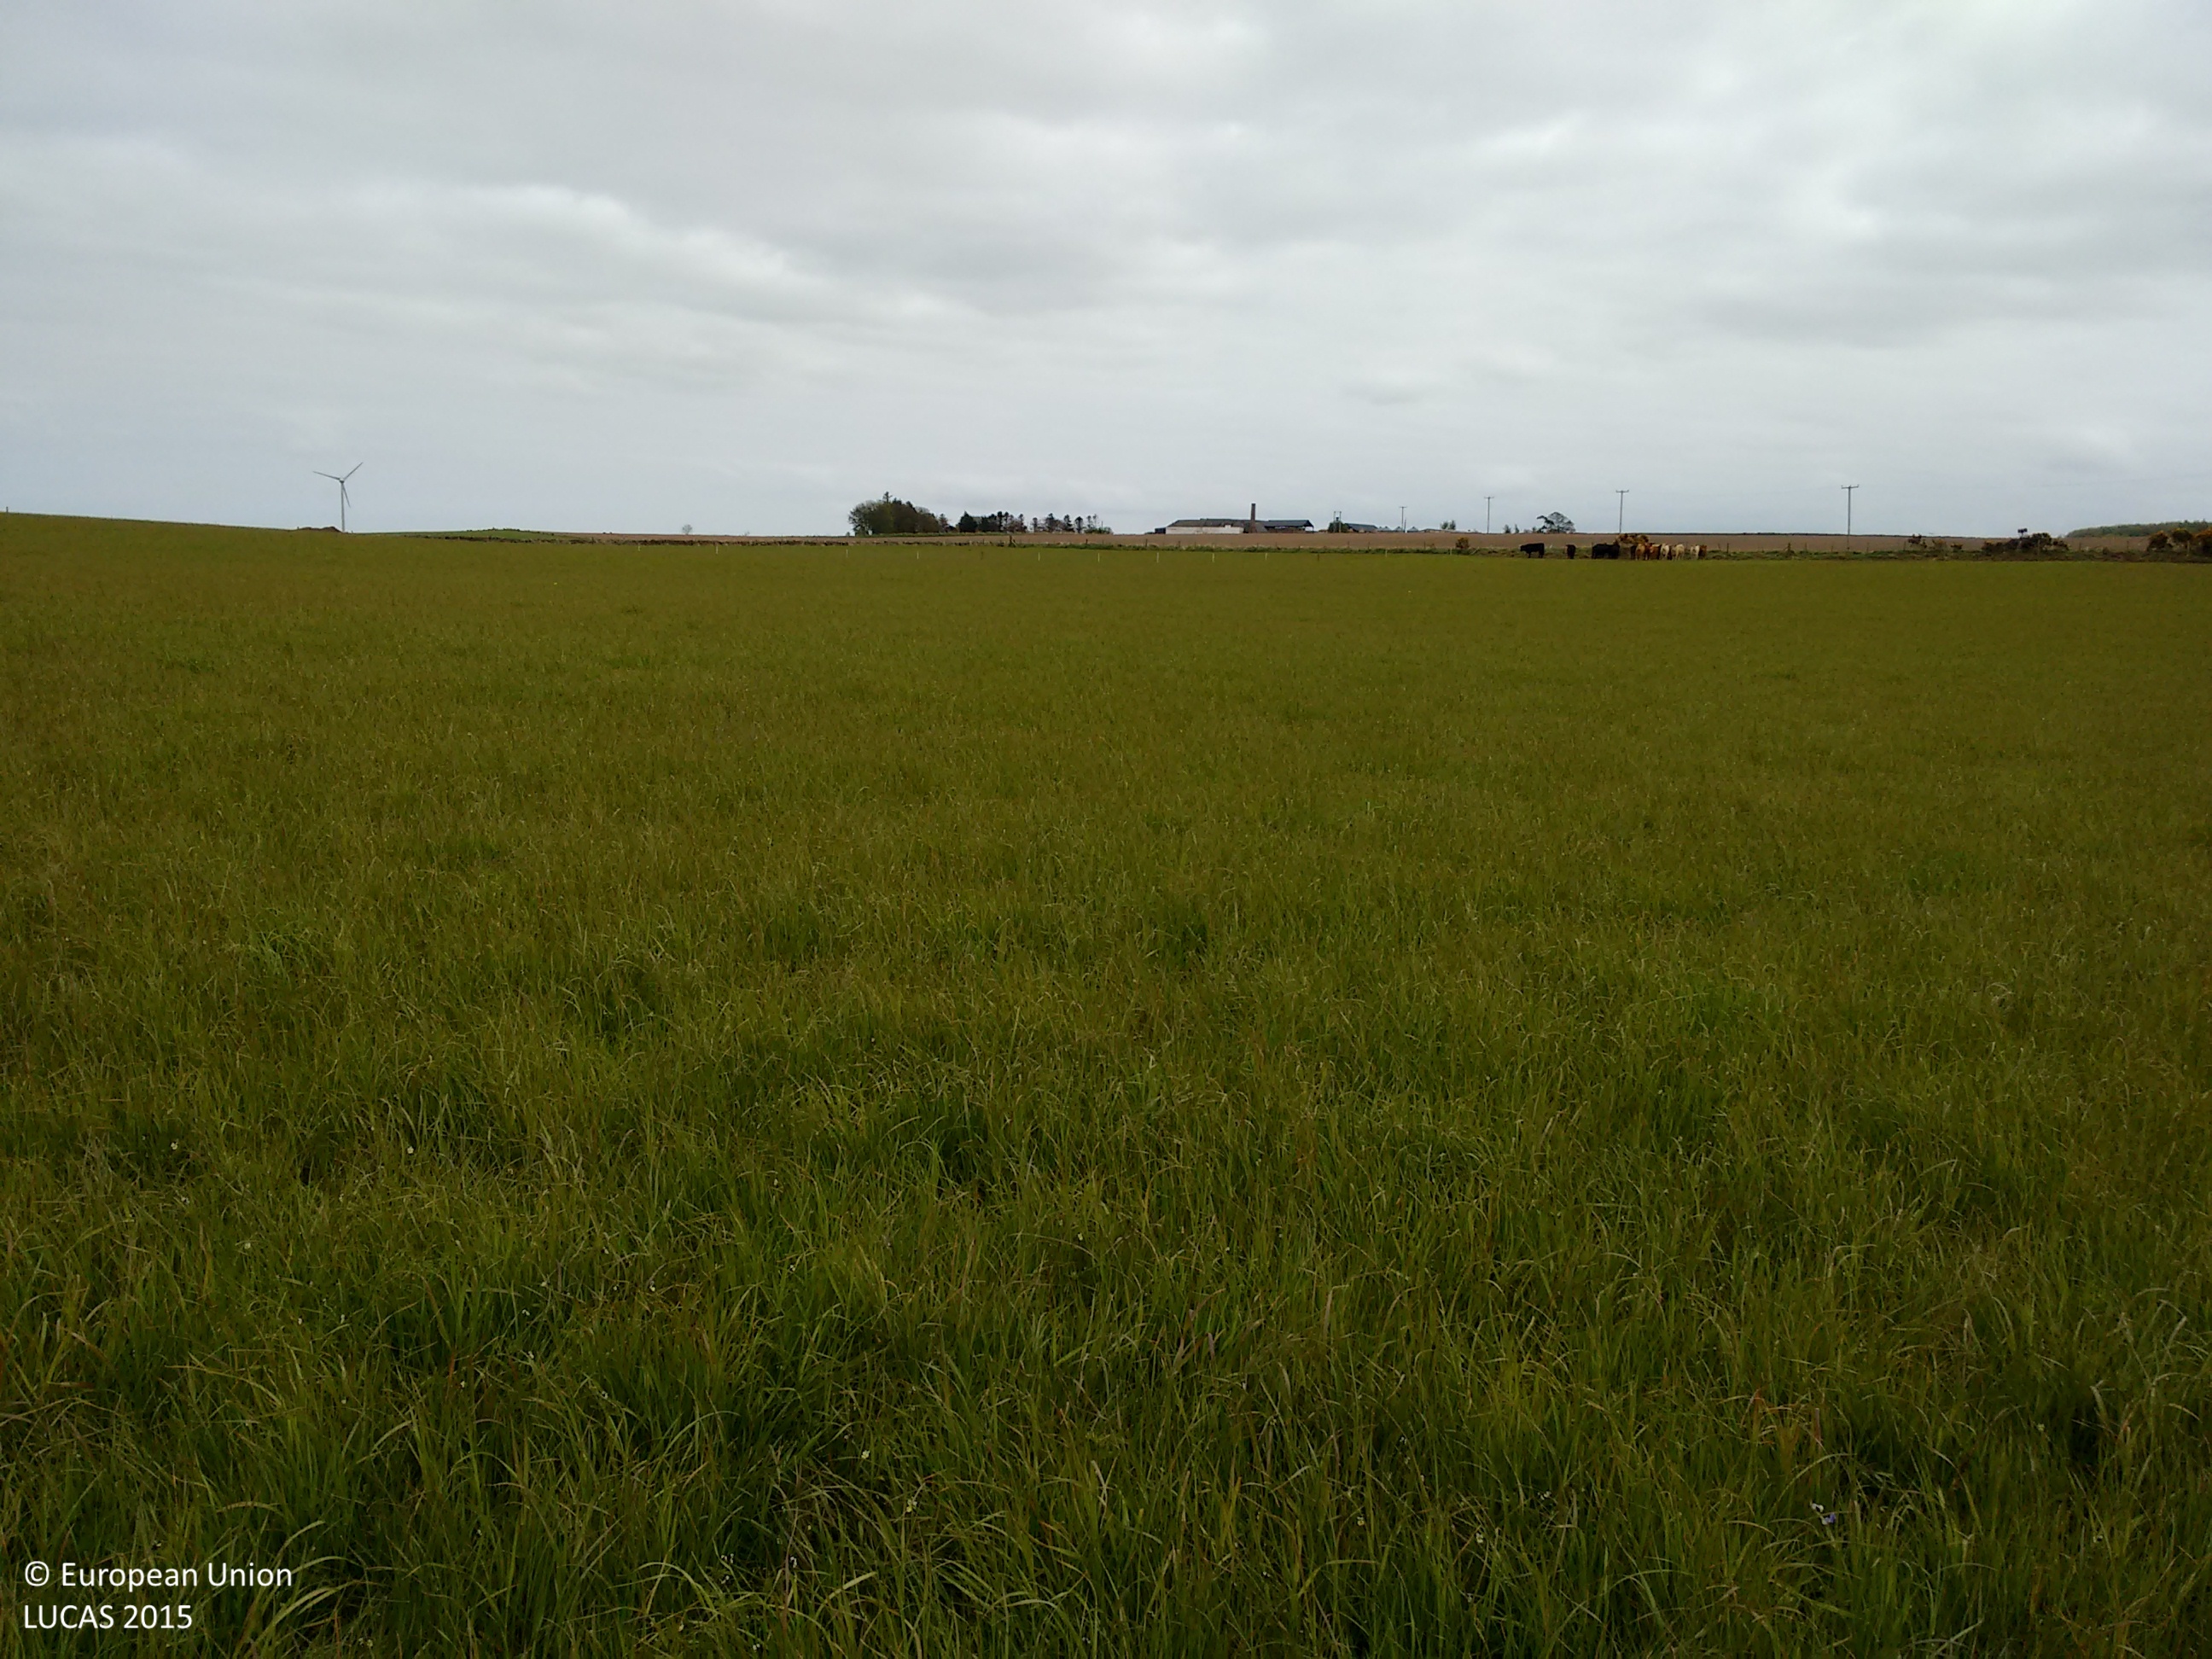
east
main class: Cropland
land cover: Temporary grasslands
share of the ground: > 75 %
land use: Agriculture (excluding fallow land and kitchen gardens)
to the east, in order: Temporary grasslands; Fences; Temporary grasslands; Fences; Dry stone walls; Fences; Grass margins; Barley
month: May
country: GB
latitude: 56.6089
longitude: -2.7194
